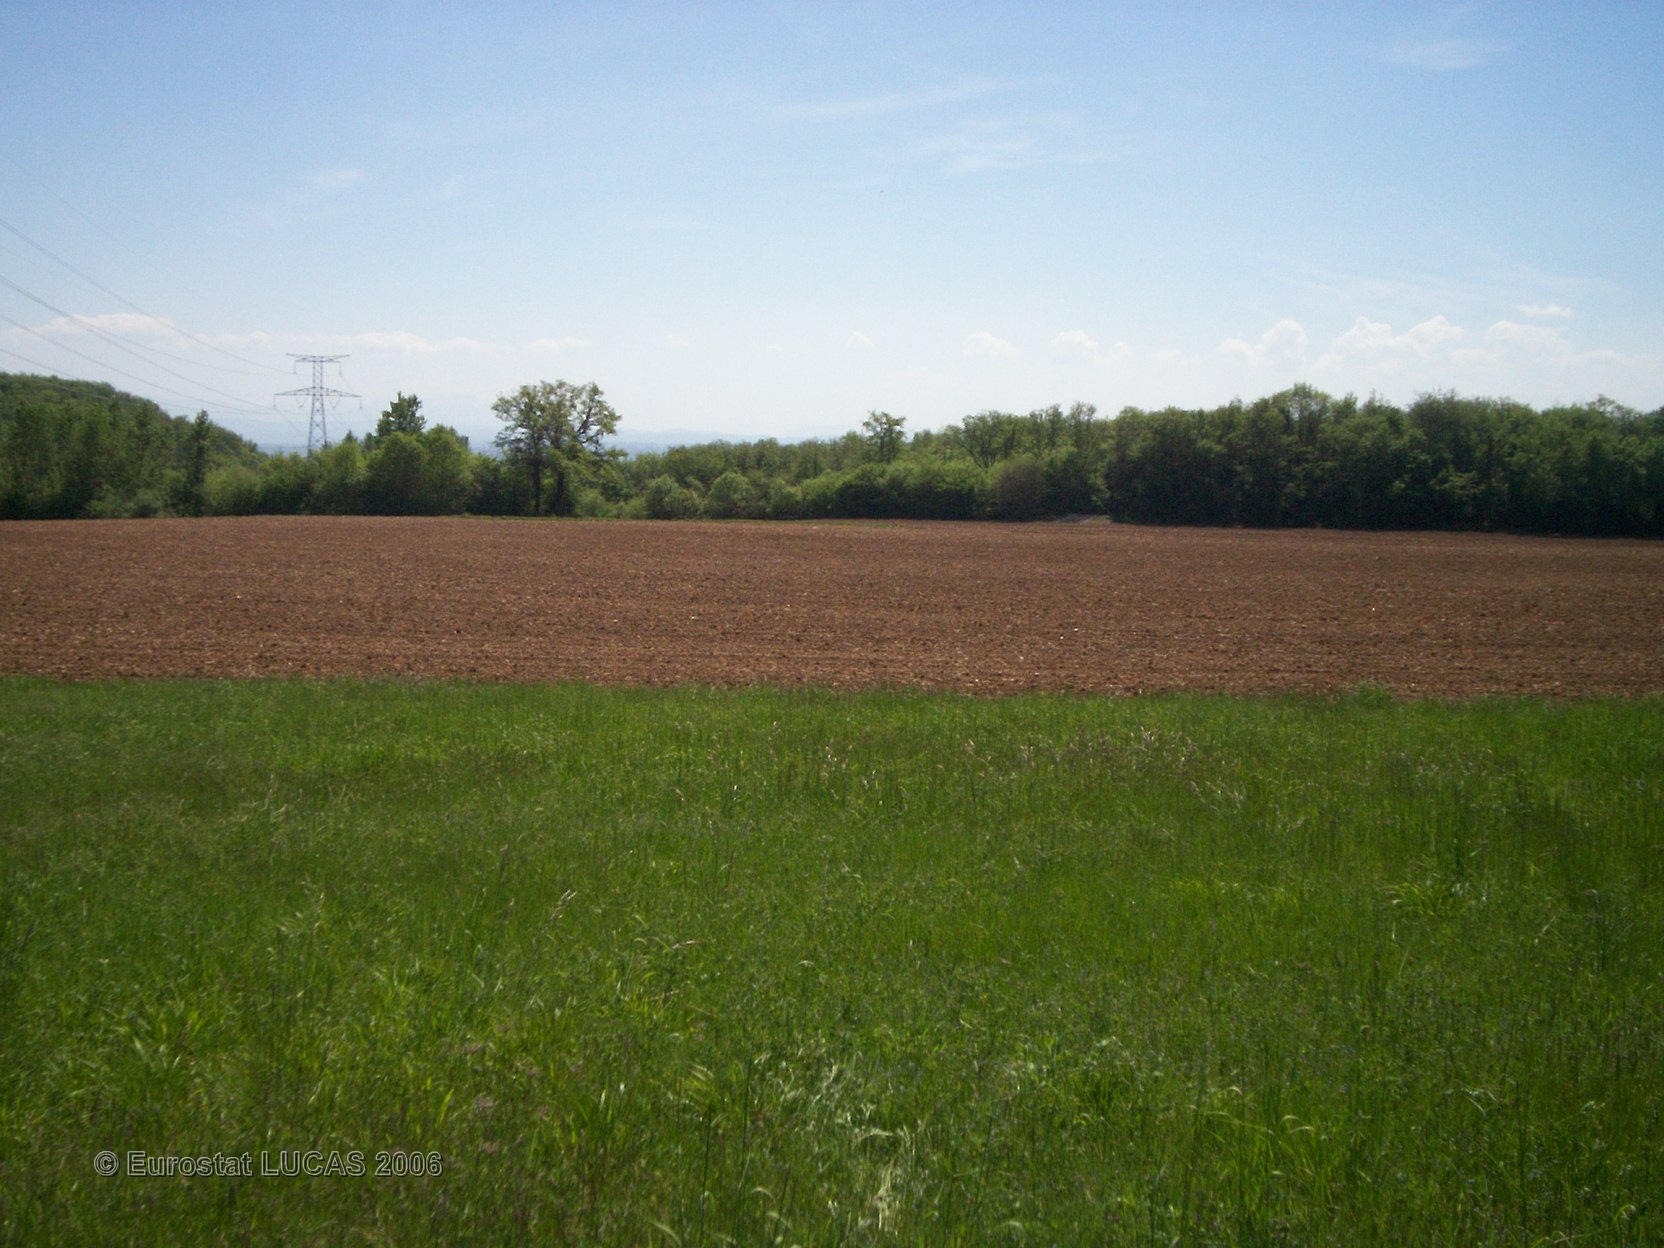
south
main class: Grassland
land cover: Grassland without tree/shrub cover
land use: Agriculture (excluding fallow land and kitchen gardens)
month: May
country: FR
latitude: 45.7320
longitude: 5.4679
